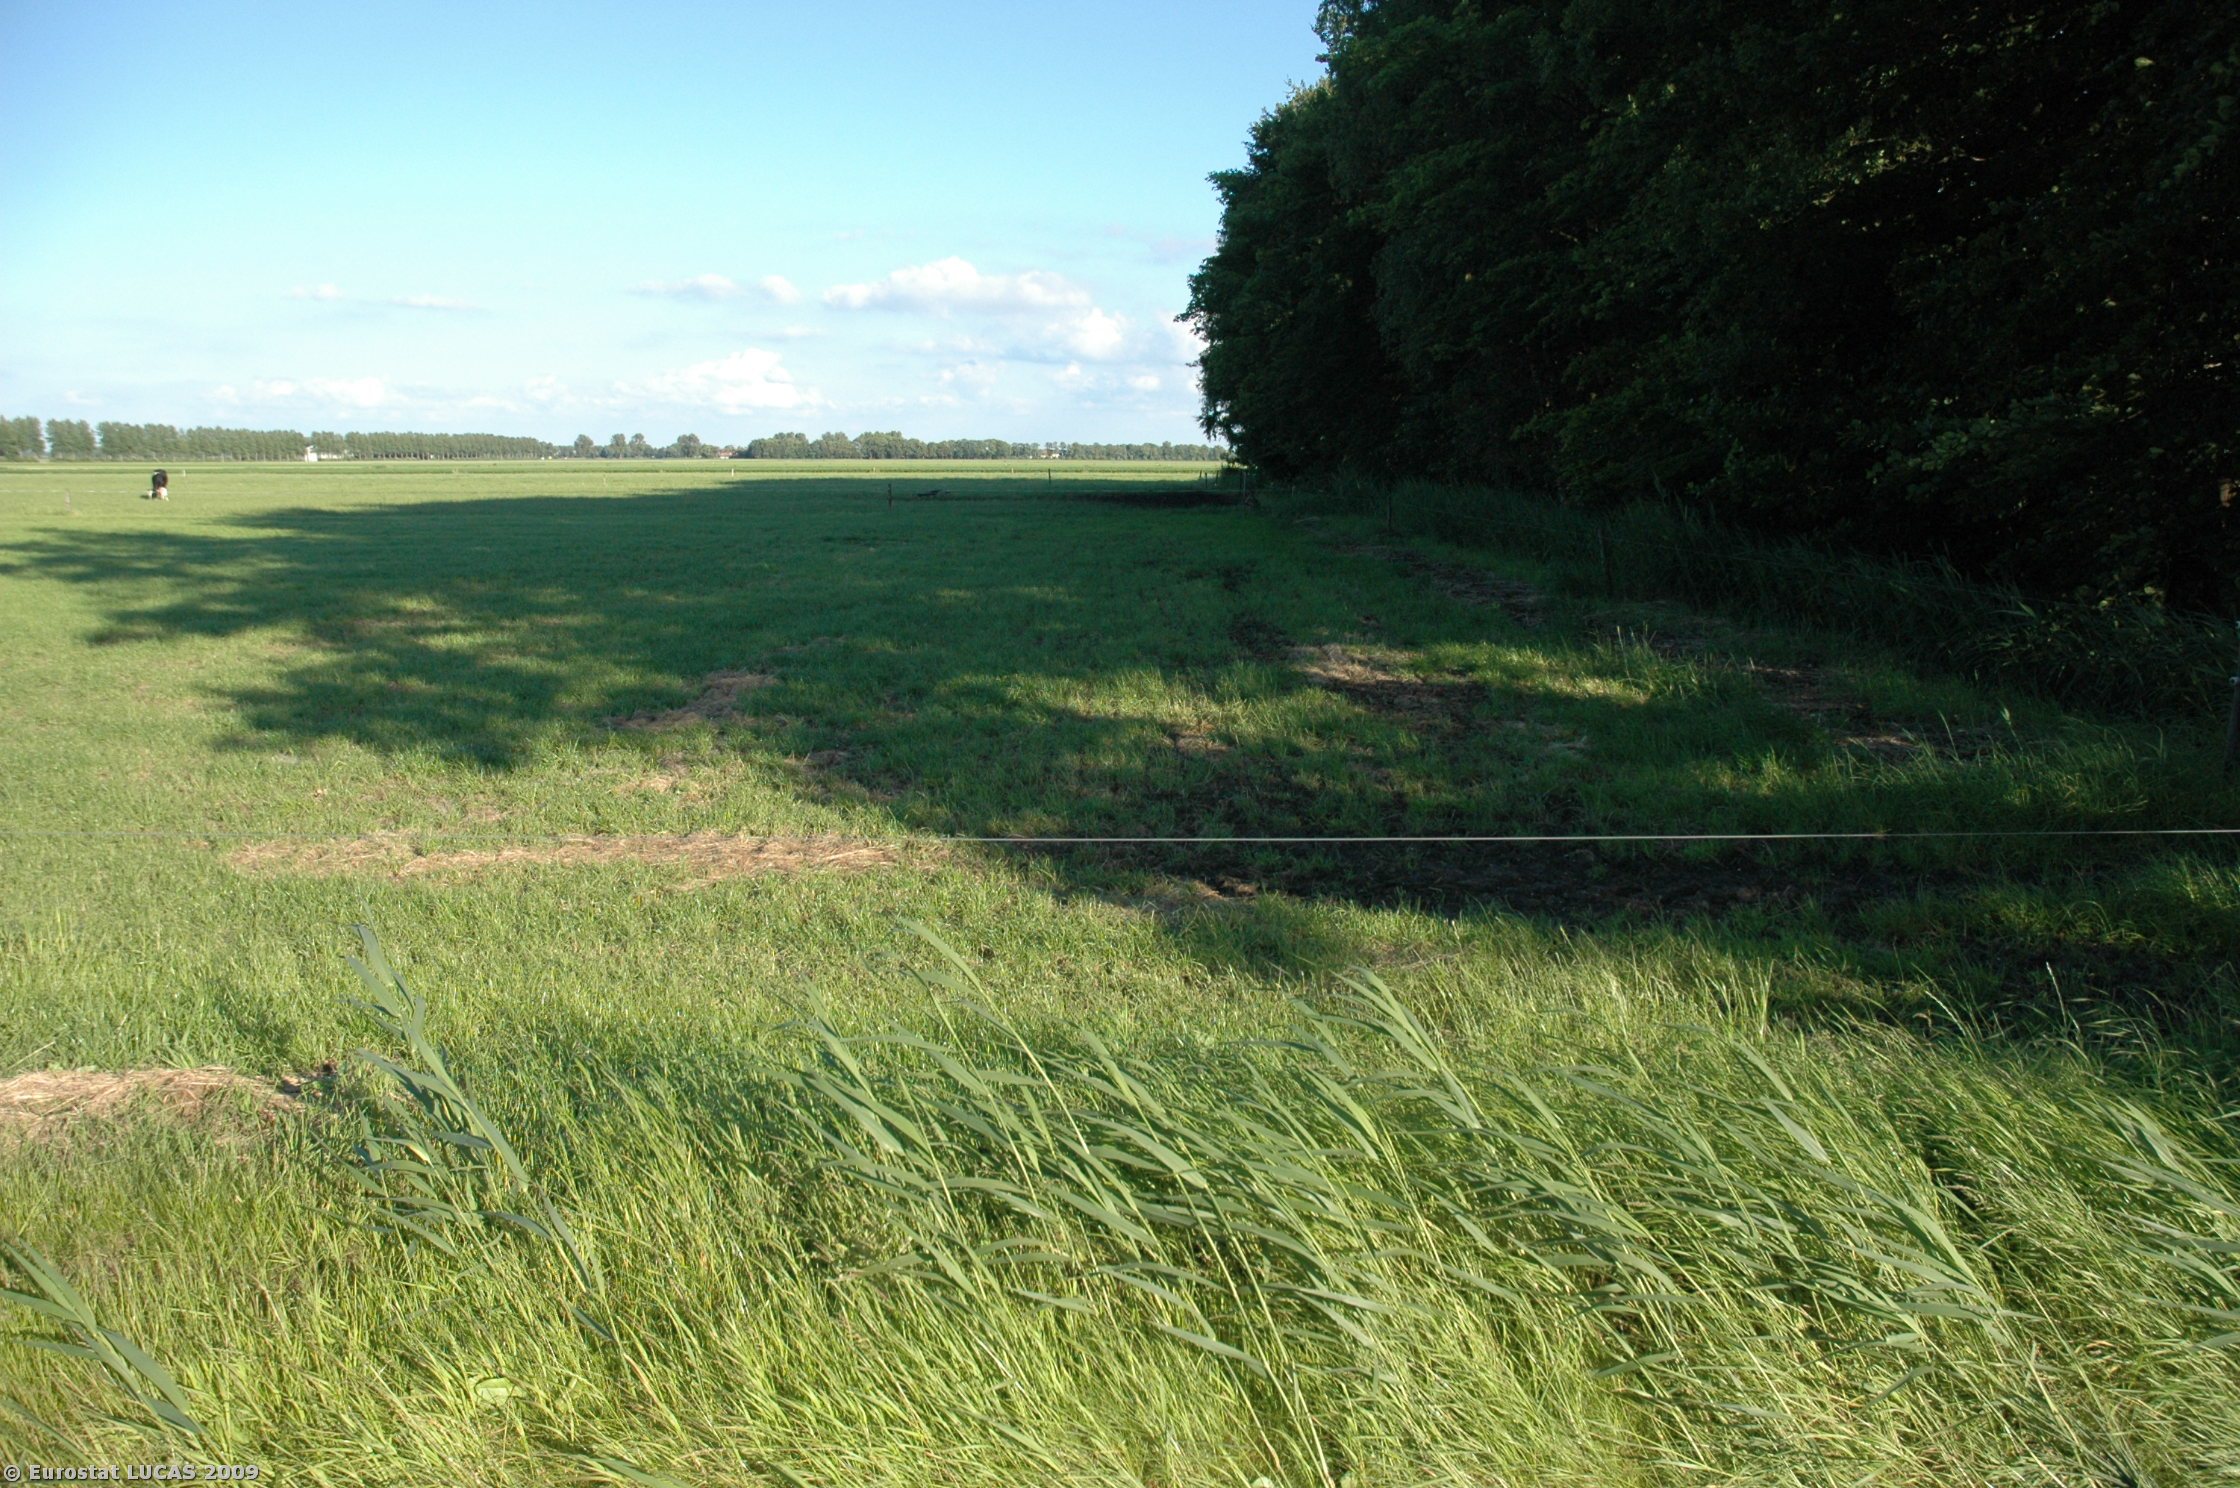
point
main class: Grassland
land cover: Grassland without tree/shrub cover
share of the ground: > 75 %
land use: Agriculture (excluding fallow land and kitchen gardens)
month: June
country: NL
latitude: 52.6753
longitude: 5.6358
